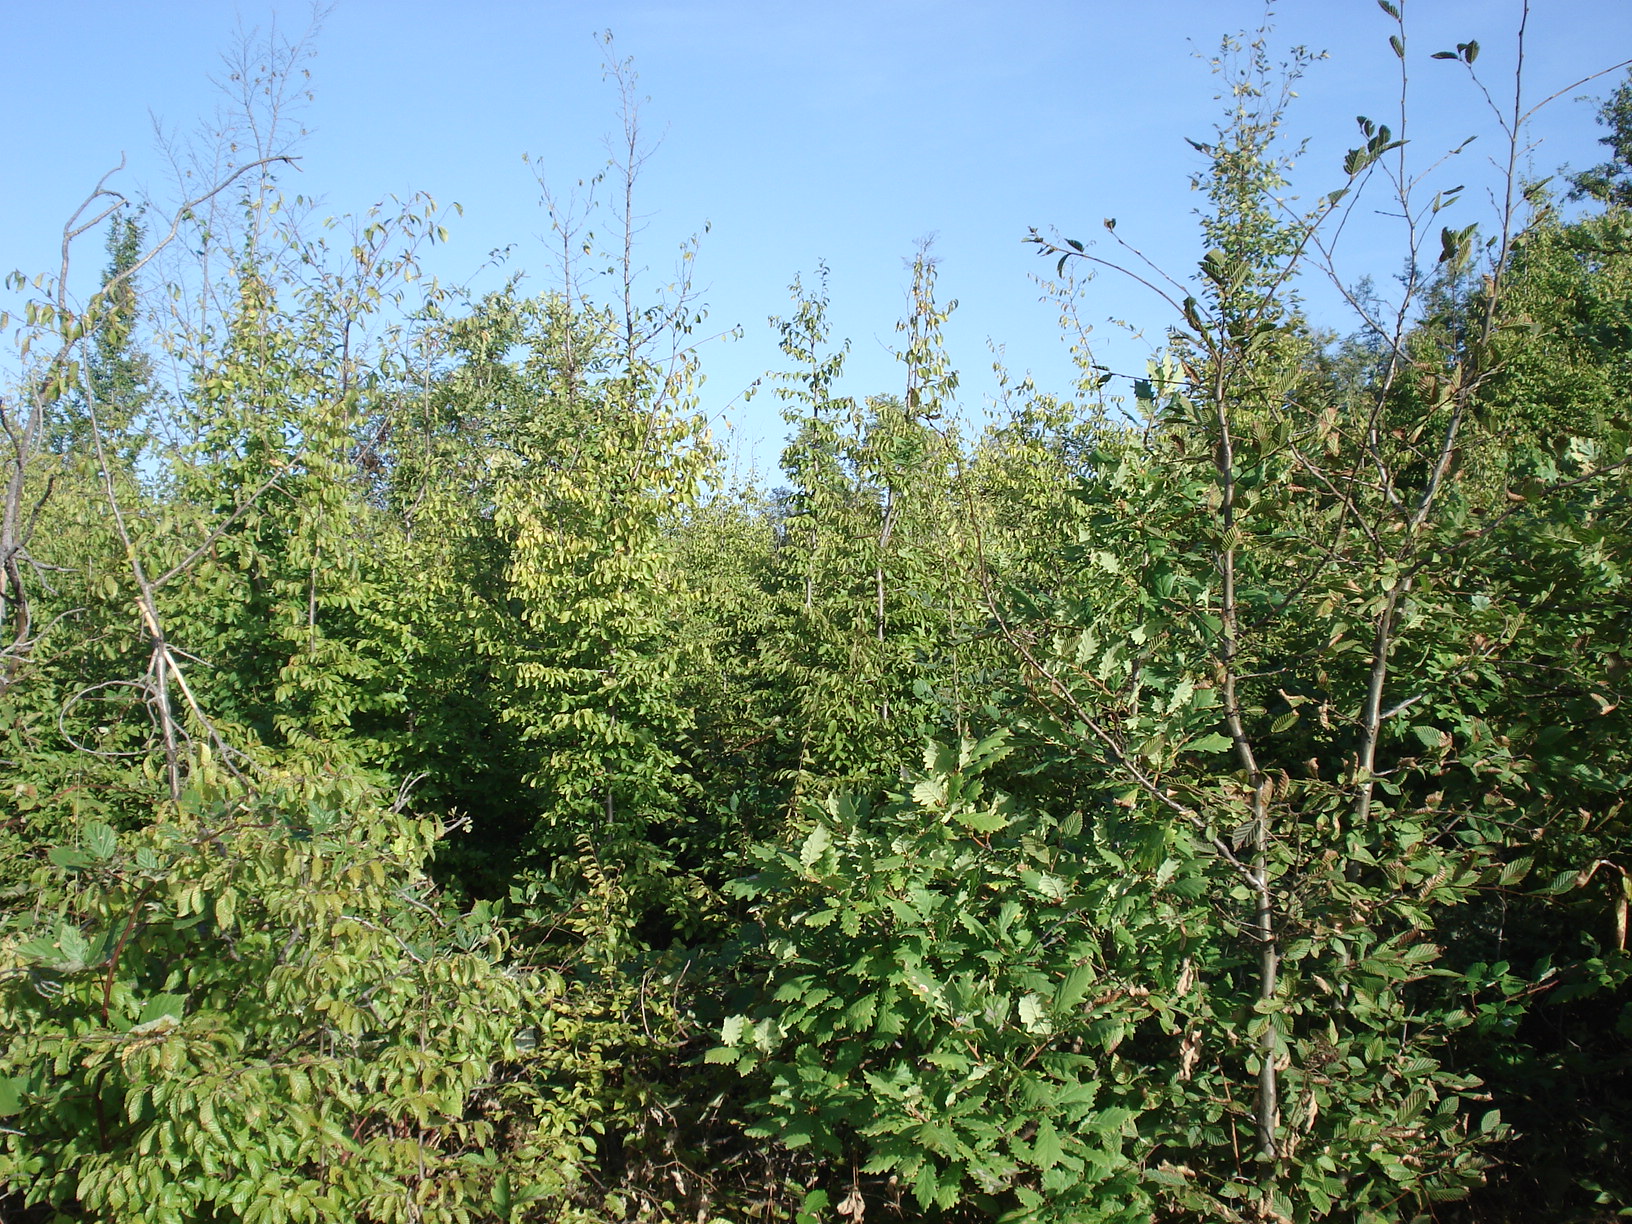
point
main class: Woodland
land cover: Pine dominated mixed woodland
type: hemiboreal forest and nemoral coniferous forest and mixed broadleaved-coniferous forest
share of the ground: 50 - 75 %
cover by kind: coniferous forest trees 35 %, broadleaved forest trees 35 %, shrubs 20 %, herbaceous plants 10 %
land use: Forestry
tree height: < 5 m
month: September
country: BG
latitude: 42.9224
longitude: 25.7248
